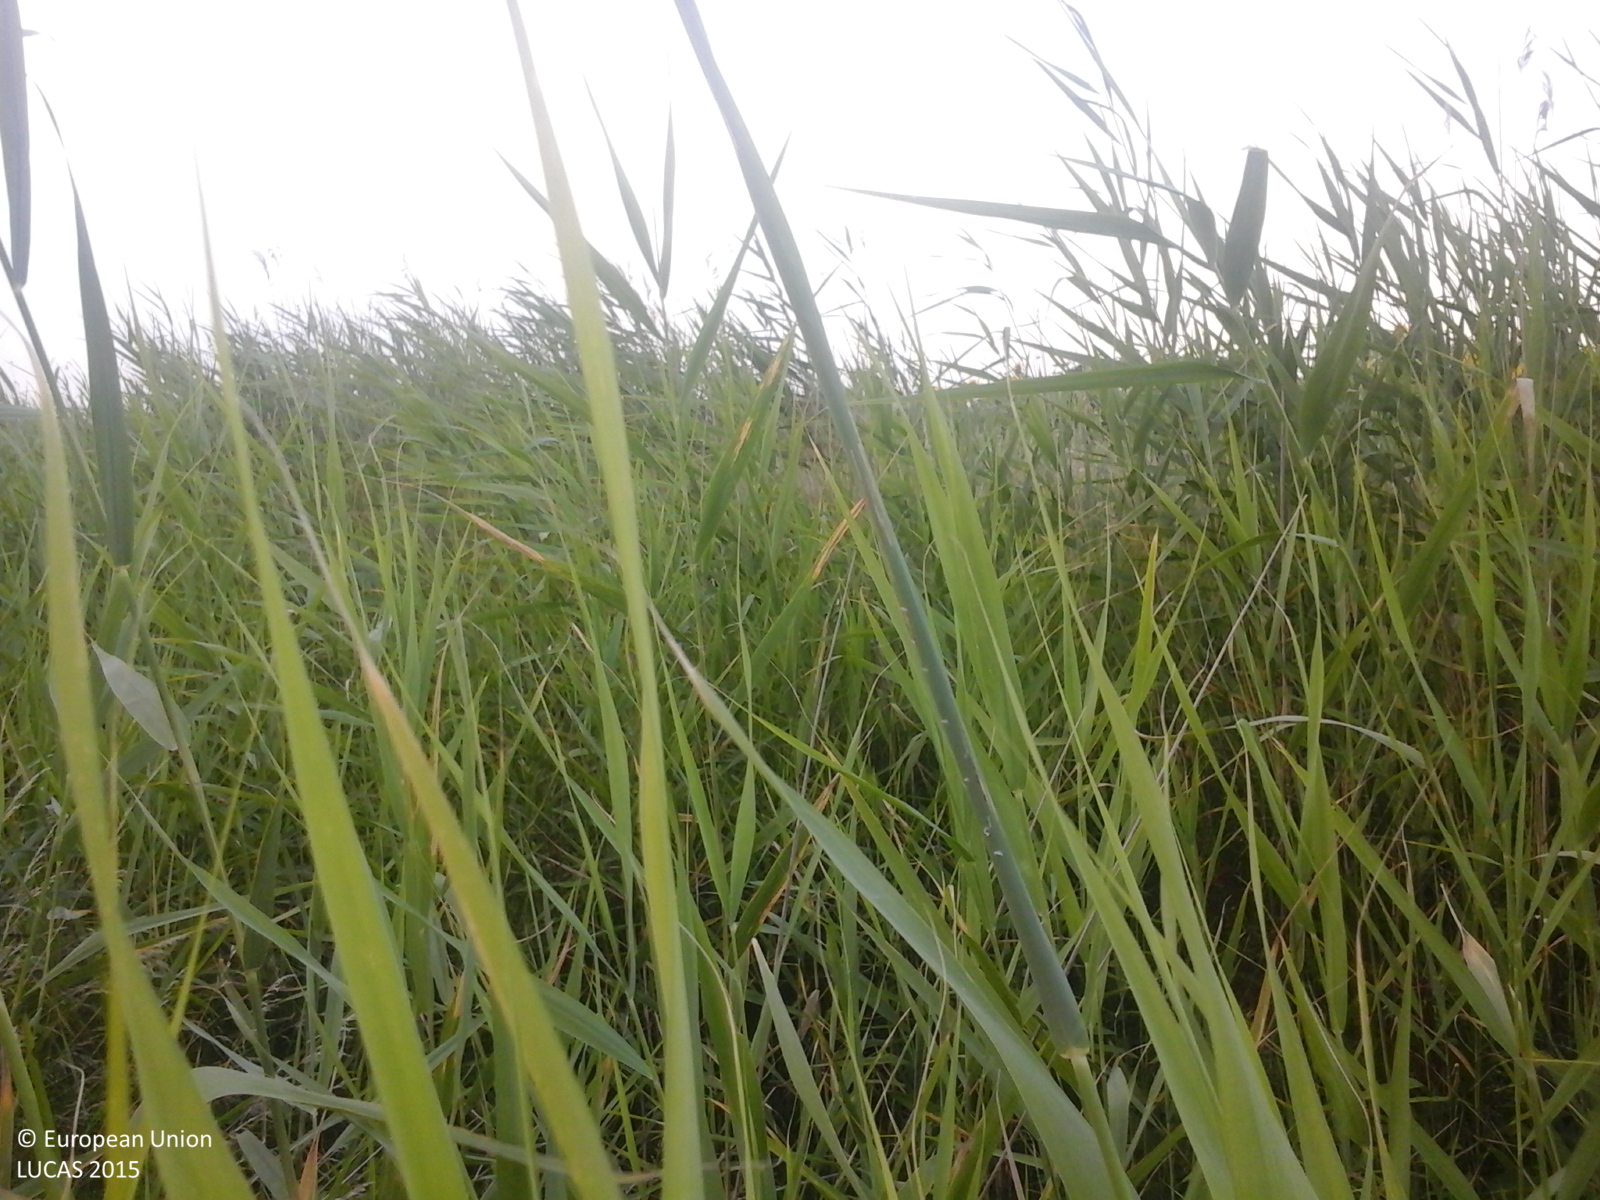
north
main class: Grassland
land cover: Spontaneously vegetated surfaces
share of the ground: 50 - 75 %
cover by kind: herbaceous plants 100 %
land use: Agriculture (excluding fallow land and kitchen gardens)
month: July
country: RO
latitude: 43.8484
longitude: 24.6847
